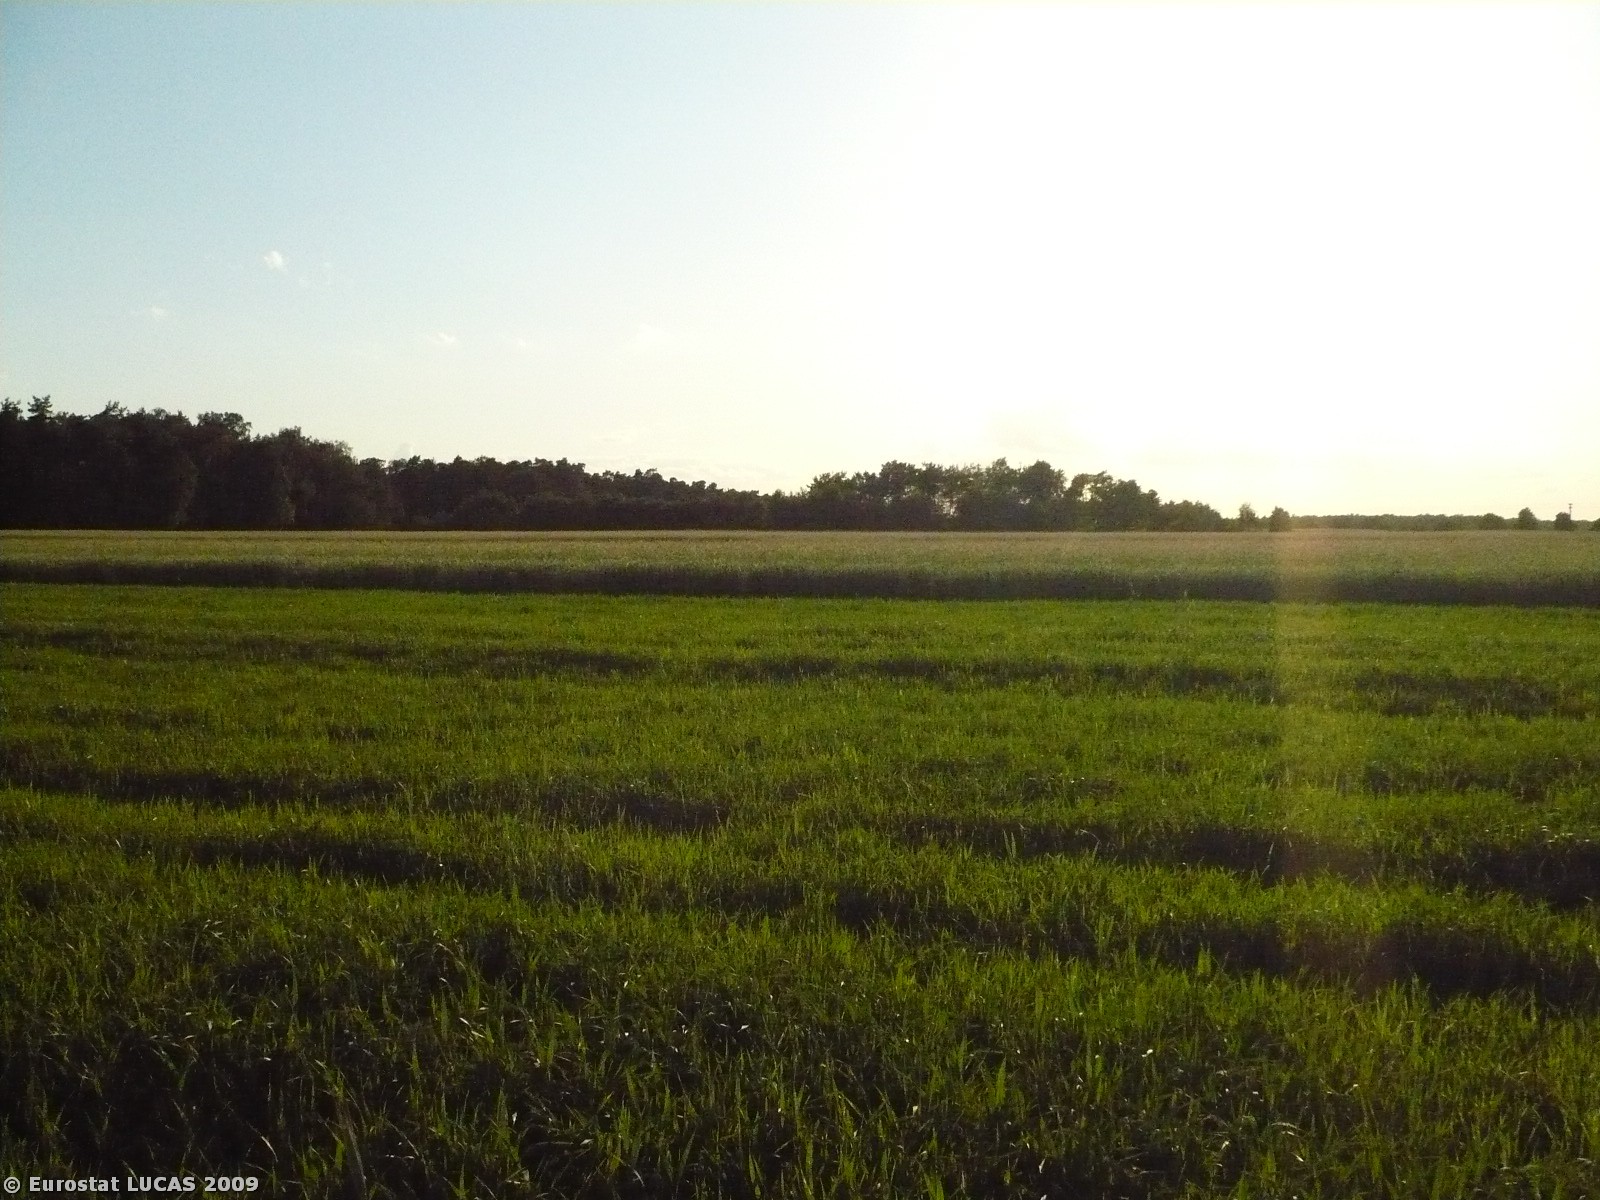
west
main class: Cropland
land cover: Rye
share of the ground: > 75 %
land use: Agriculture (excluding fallow land and kitchen gardens)
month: May
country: PL
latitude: 52.1721
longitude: 16.3383
